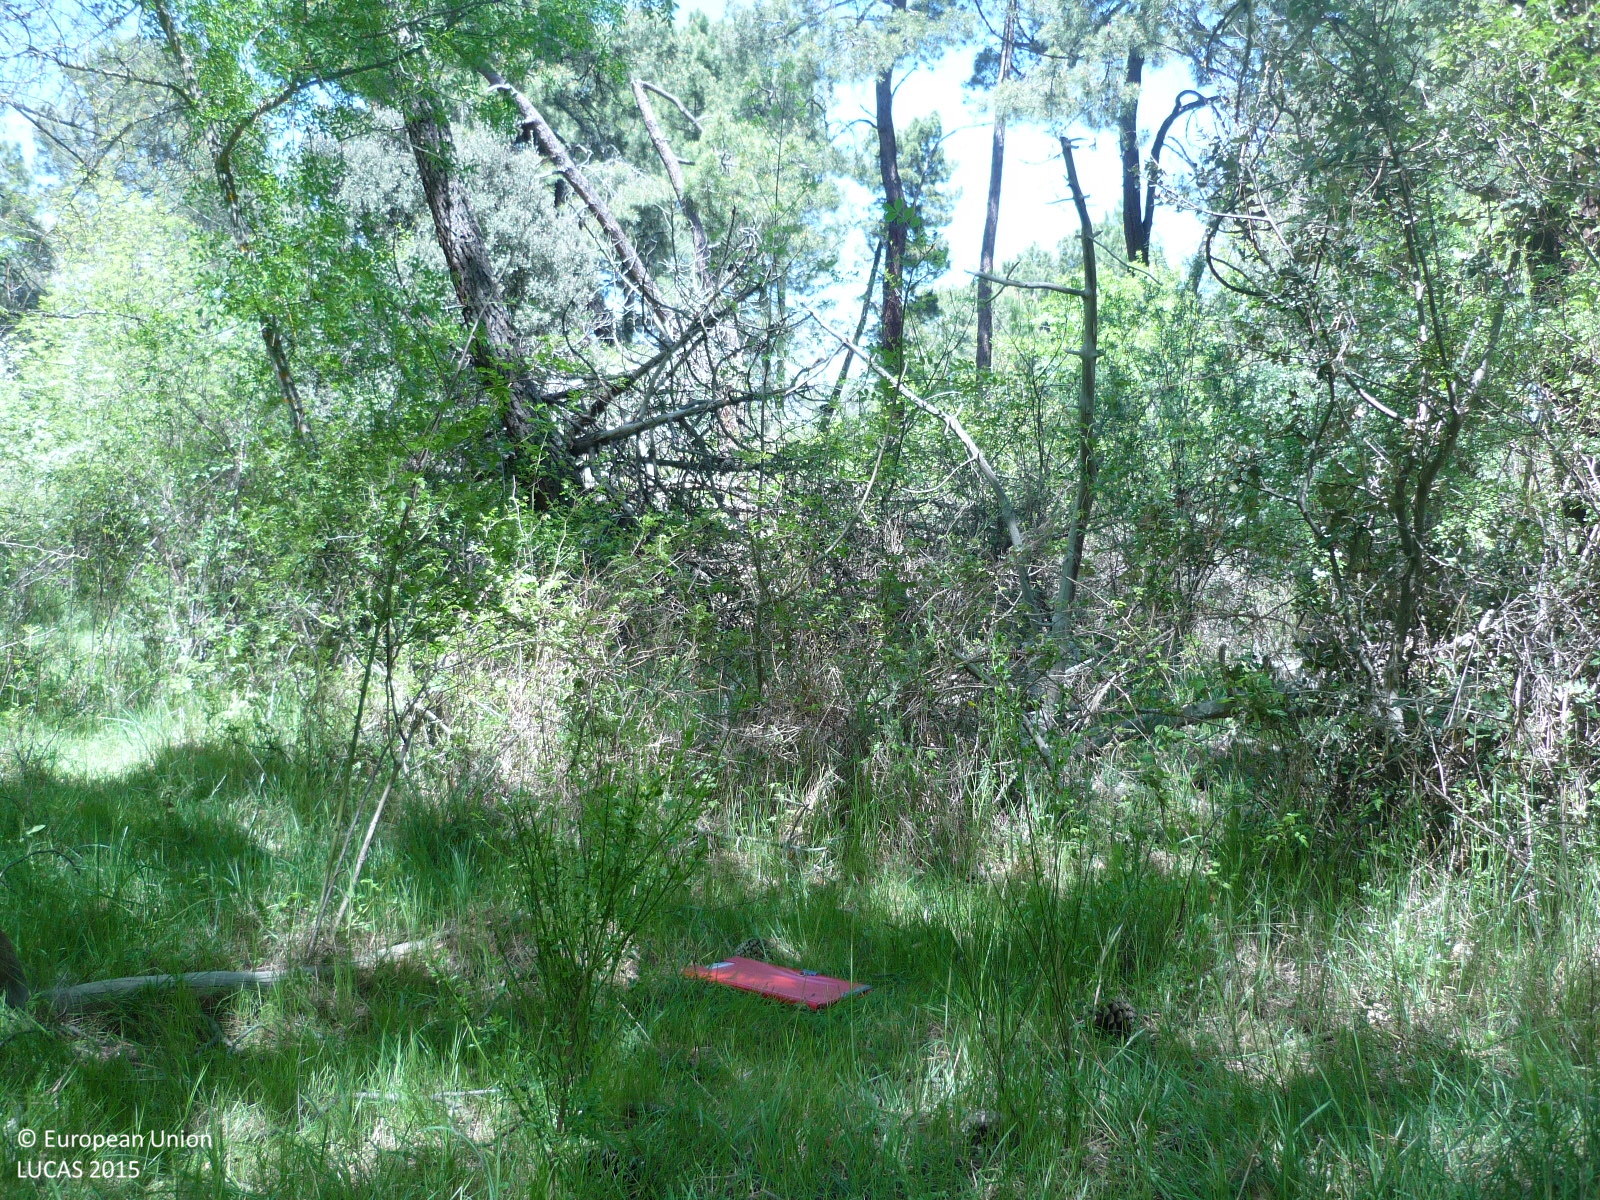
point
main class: Woodland
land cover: Broadleaved woodland
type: thermophilous deciduous forest
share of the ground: > 75 %
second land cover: Grassland without tree/shrub cover
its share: > 75 %
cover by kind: broadleaved forest trees 90 %, herbaceous plants 10 %
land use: Forestry
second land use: Agriculture (excluding fallow land and kitchen gardens)
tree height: < 5 m
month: May
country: ES
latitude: 40.9812
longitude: -3.6042
